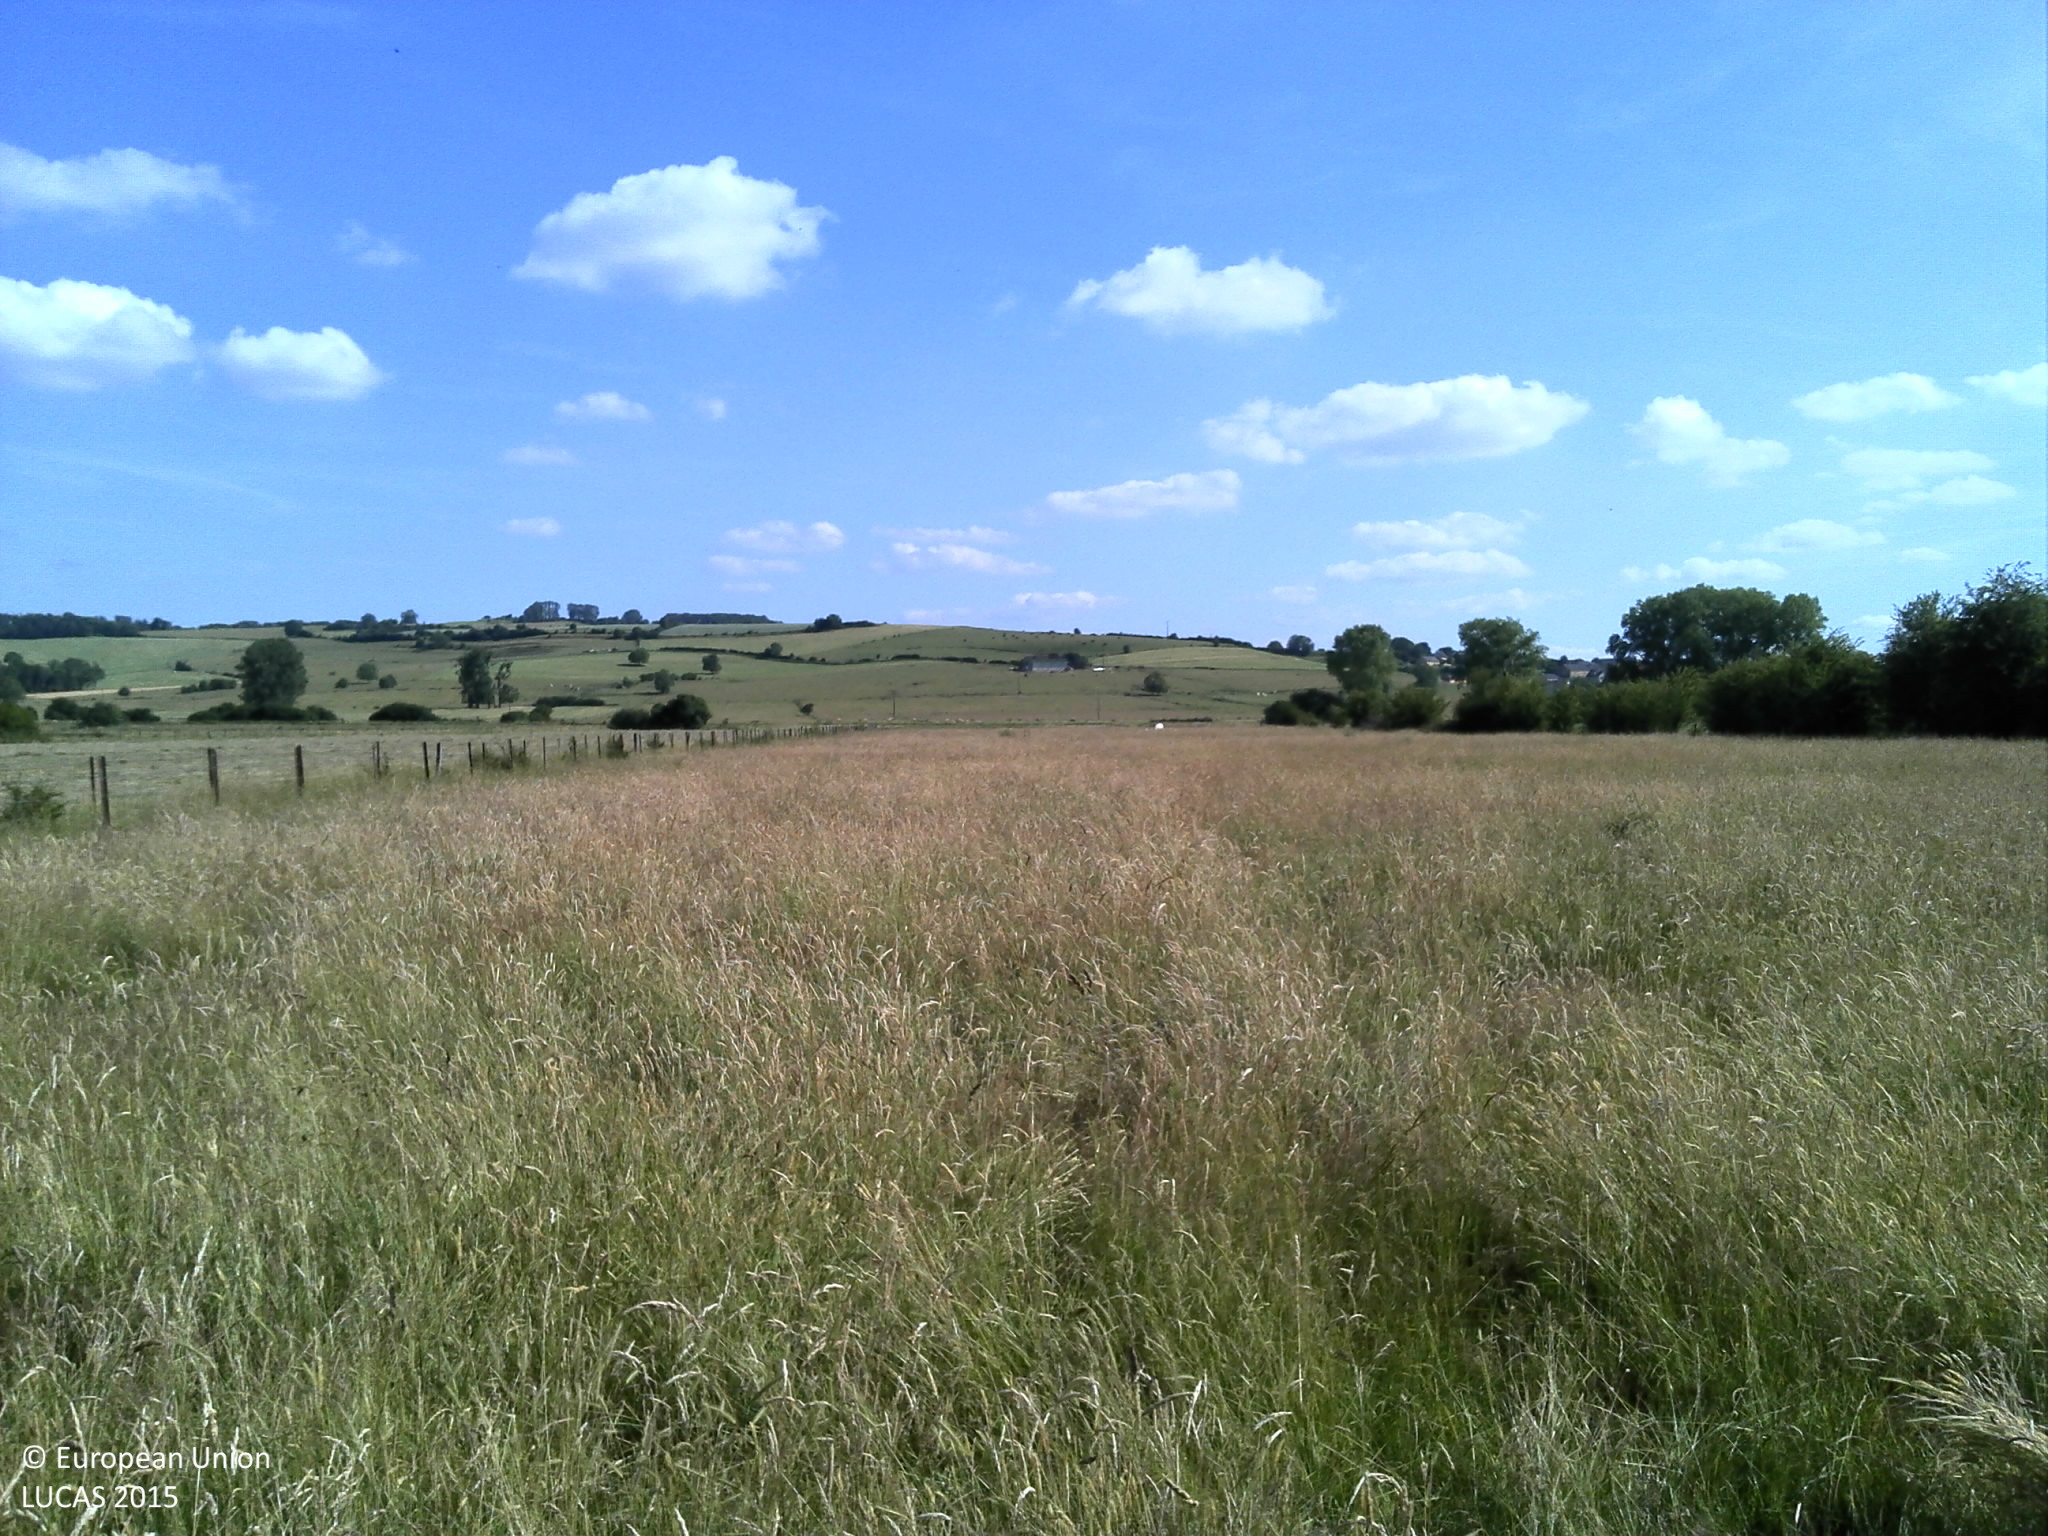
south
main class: Grassland
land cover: Grassland without tree/shrub cover
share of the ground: > 75 %
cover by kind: herbaceous plants 100 %
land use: Agriculture (excluding fallow land and kitchen gardens)
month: June
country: FR
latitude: 49.6625
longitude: 5.0517
